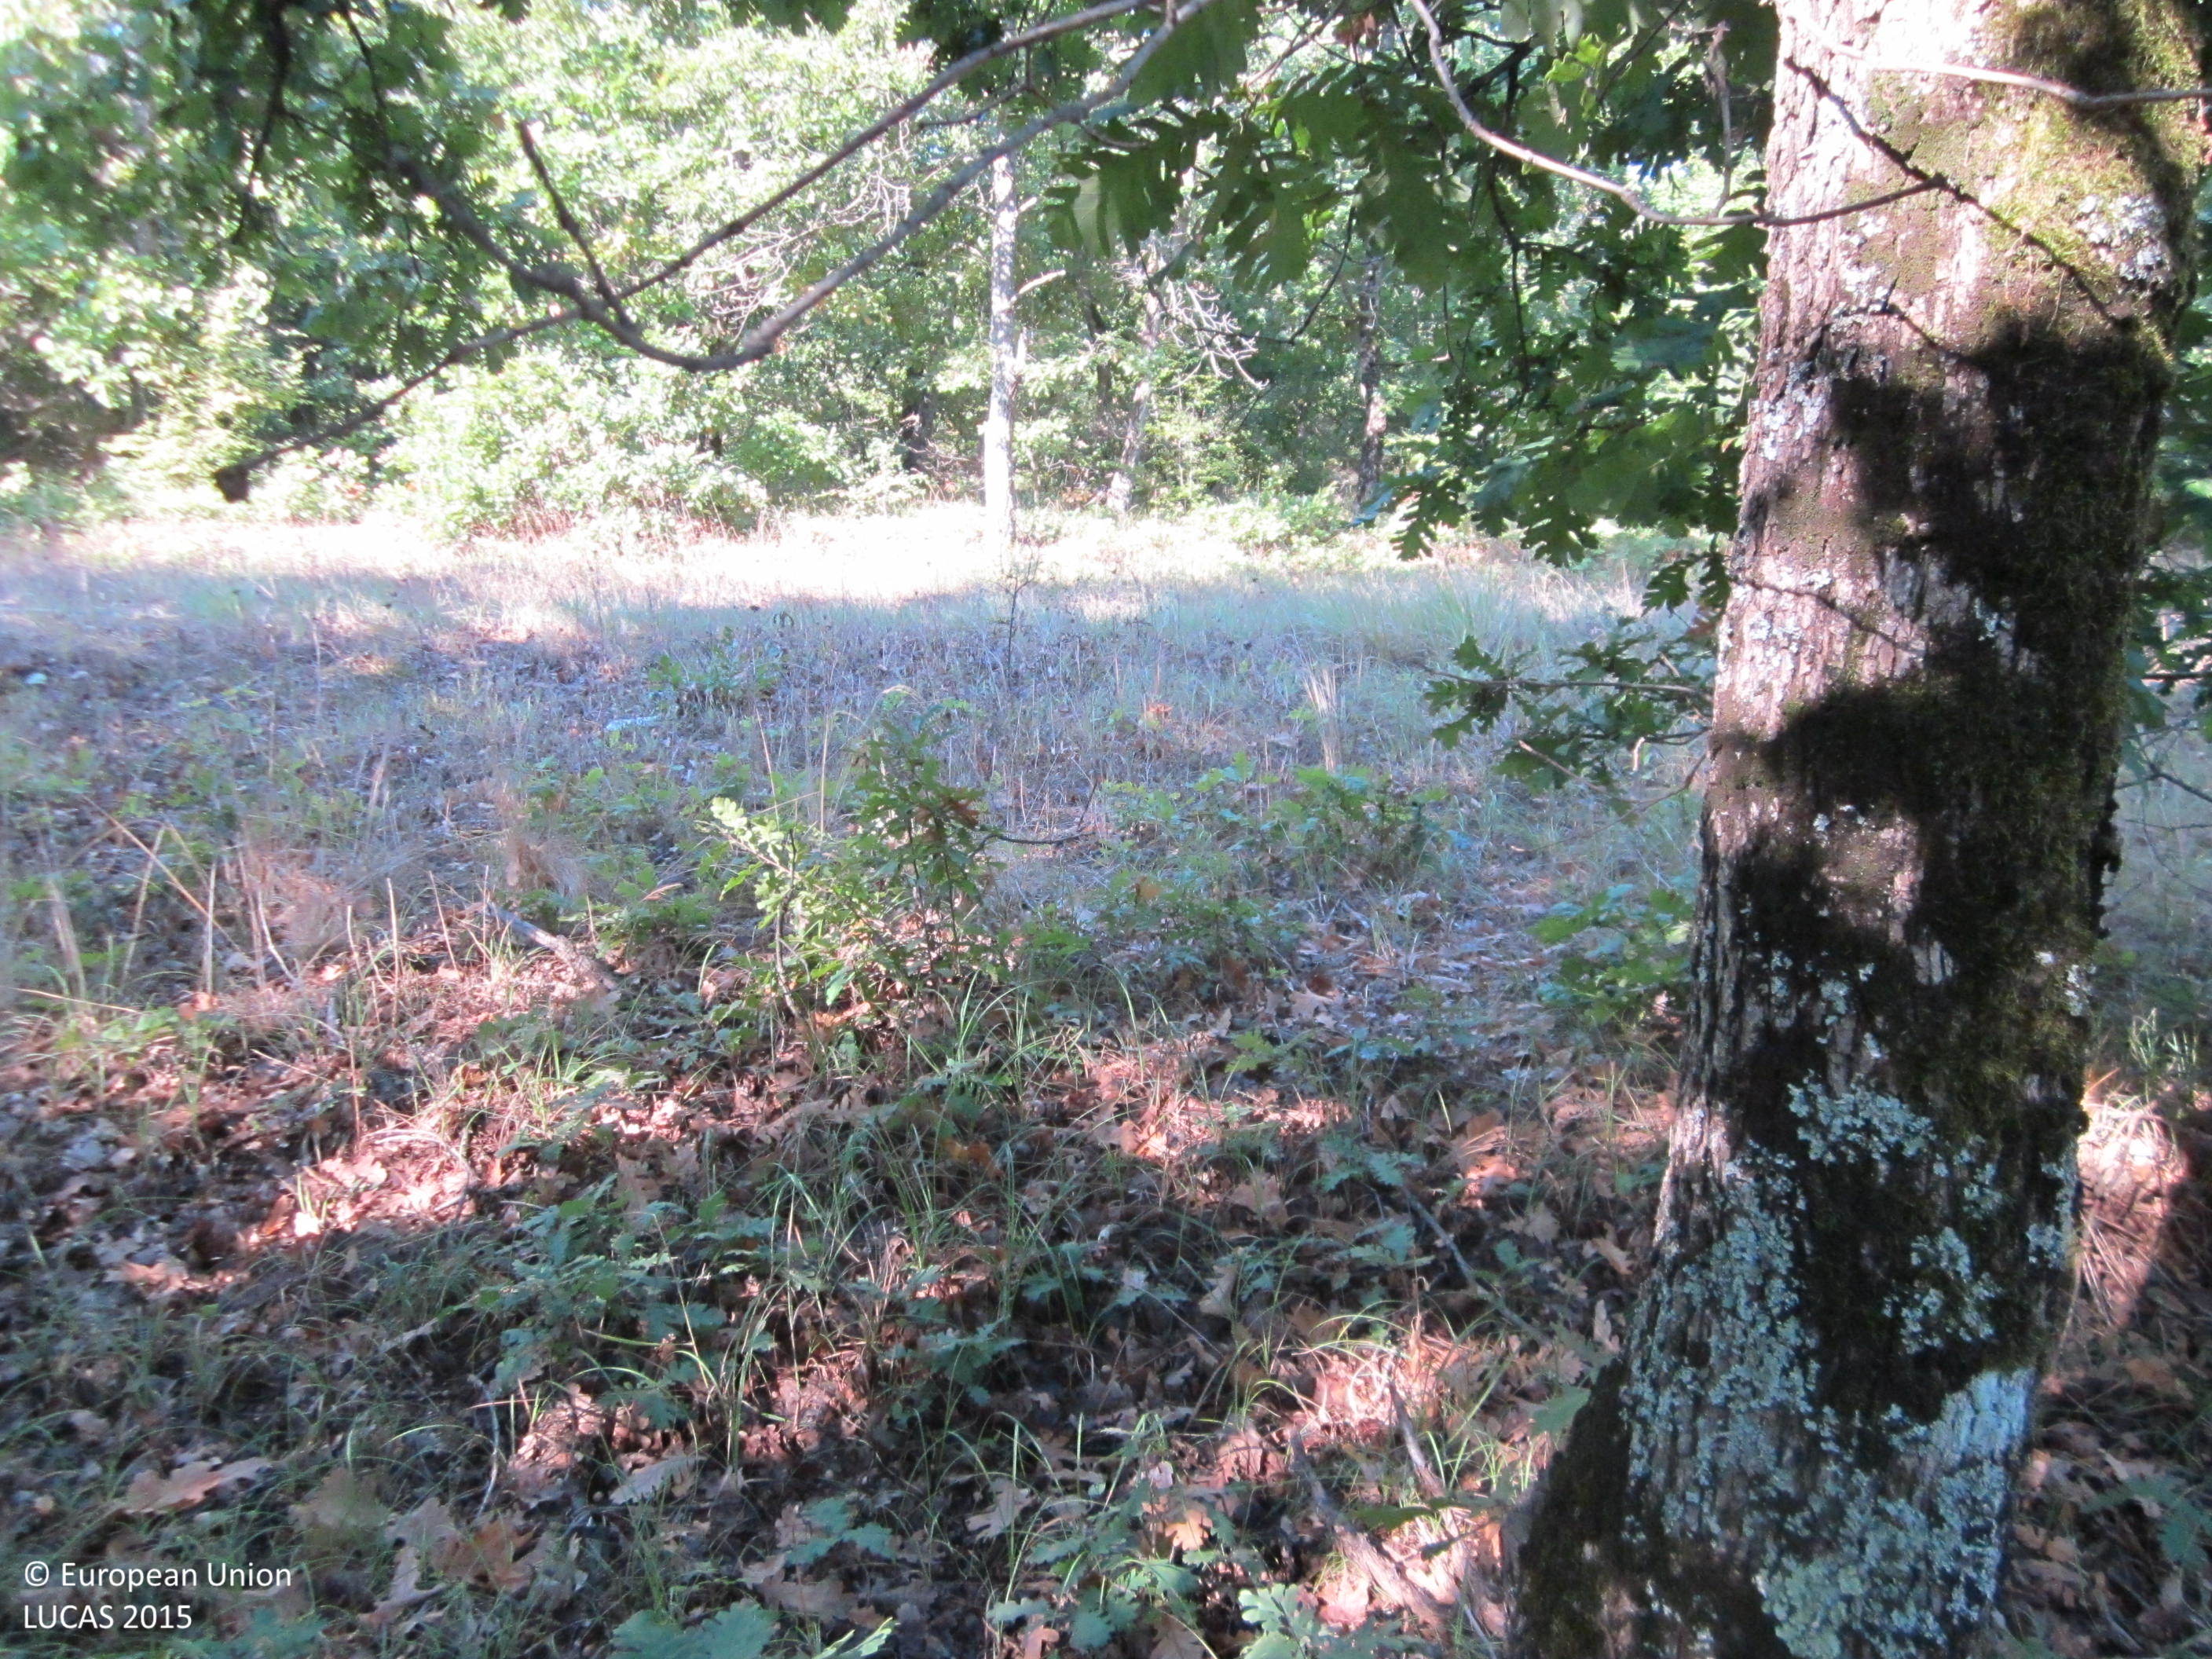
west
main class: Woodland
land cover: Broadleaved woodland
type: thermophilous deciduous forest
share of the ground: 50 - 75 %
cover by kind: broadleaved forest trees 65 %, herbaceous plants 30 %, lichens and mosses 5 %
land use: Forestry
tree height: > 5 m
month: September
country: BG
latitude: 42.3693
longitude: 27.2932
